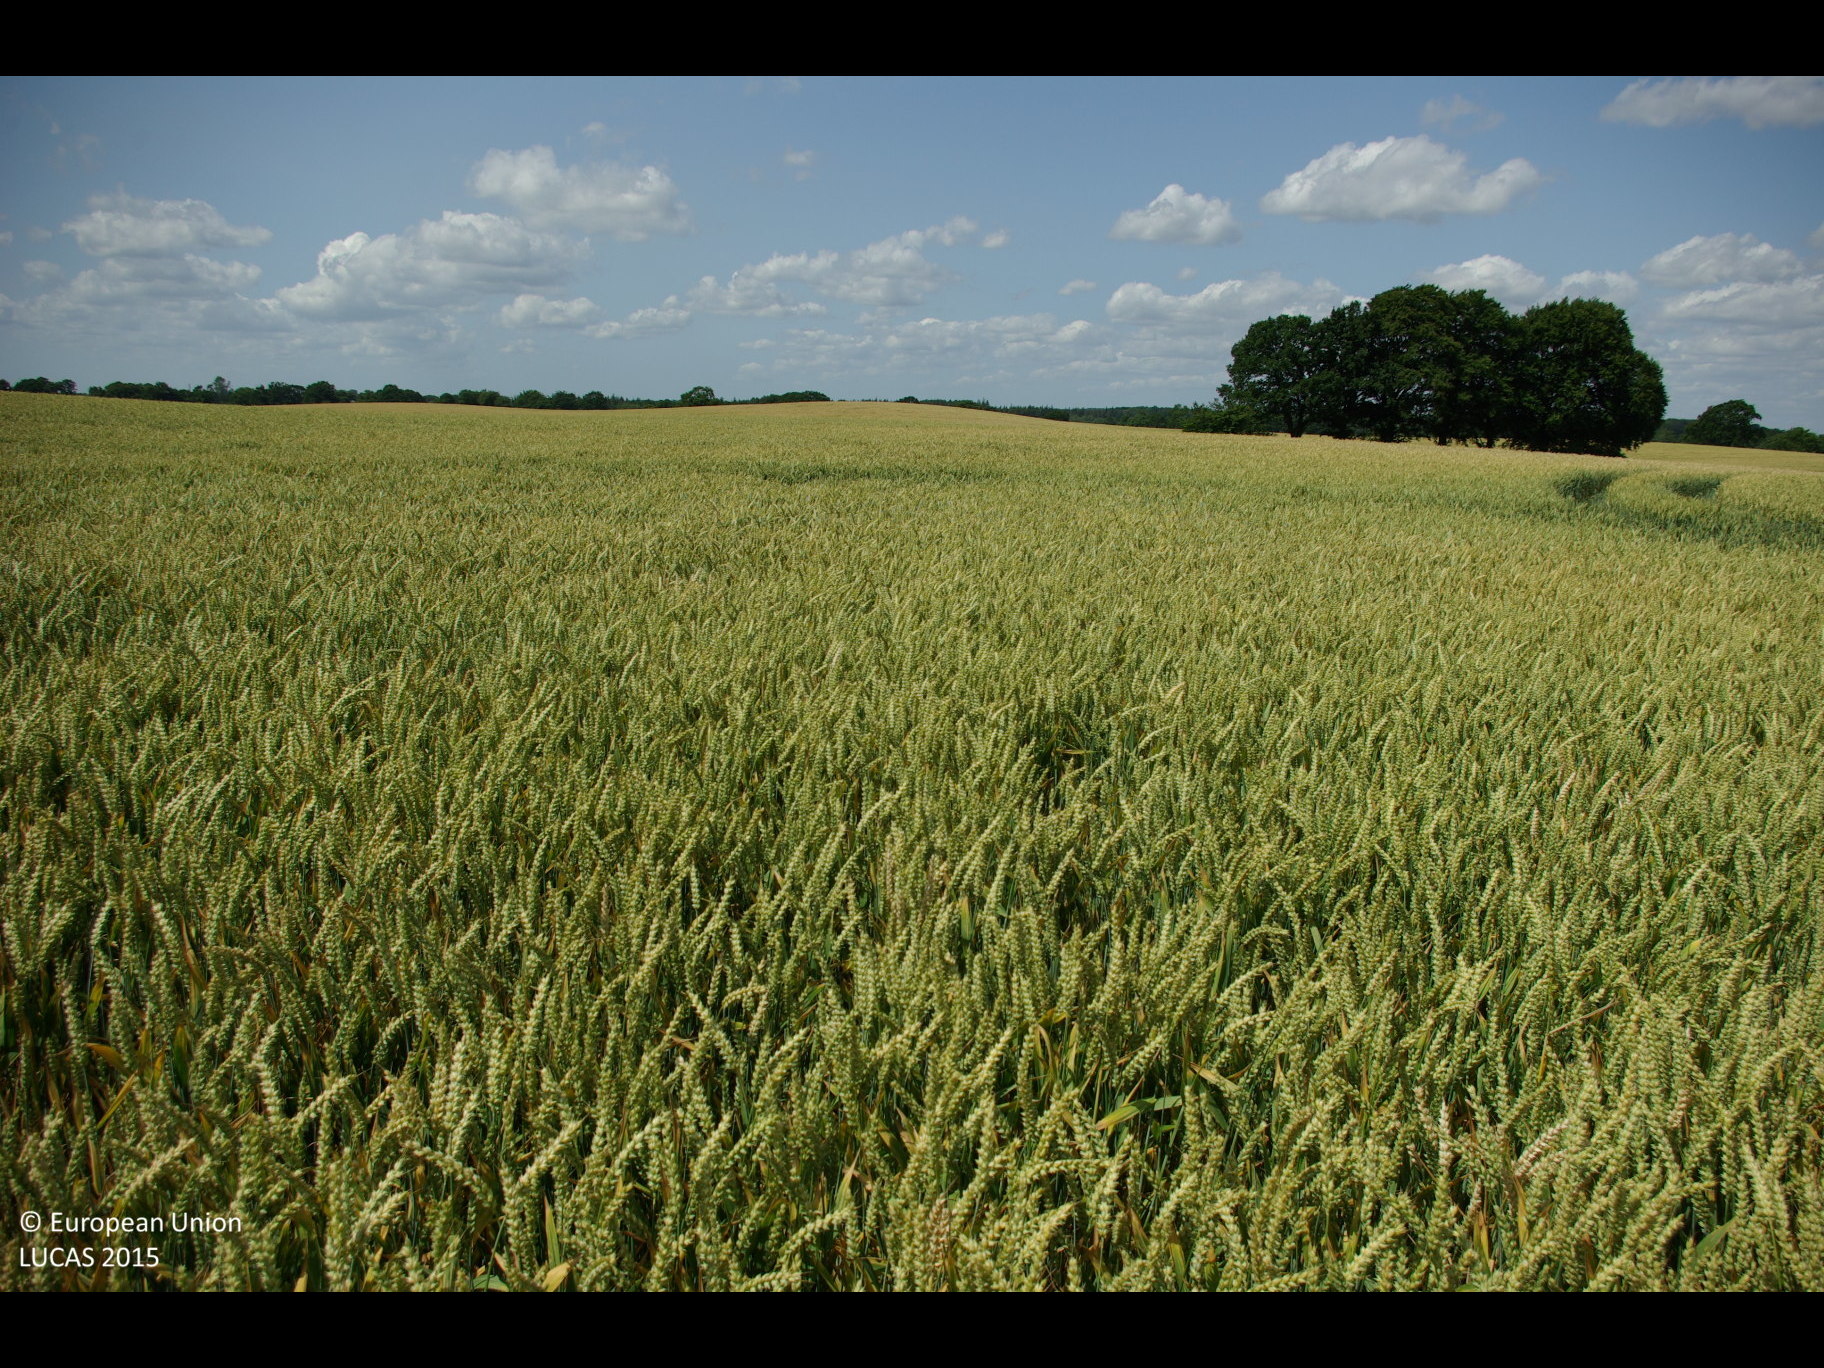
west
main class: Cropland
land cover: Common wheat
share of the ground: > 75 %
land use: Agriculture (excluding fallow land and kitchen gardens)
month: July
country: DE
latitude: 54.5341
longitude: 9.9537
